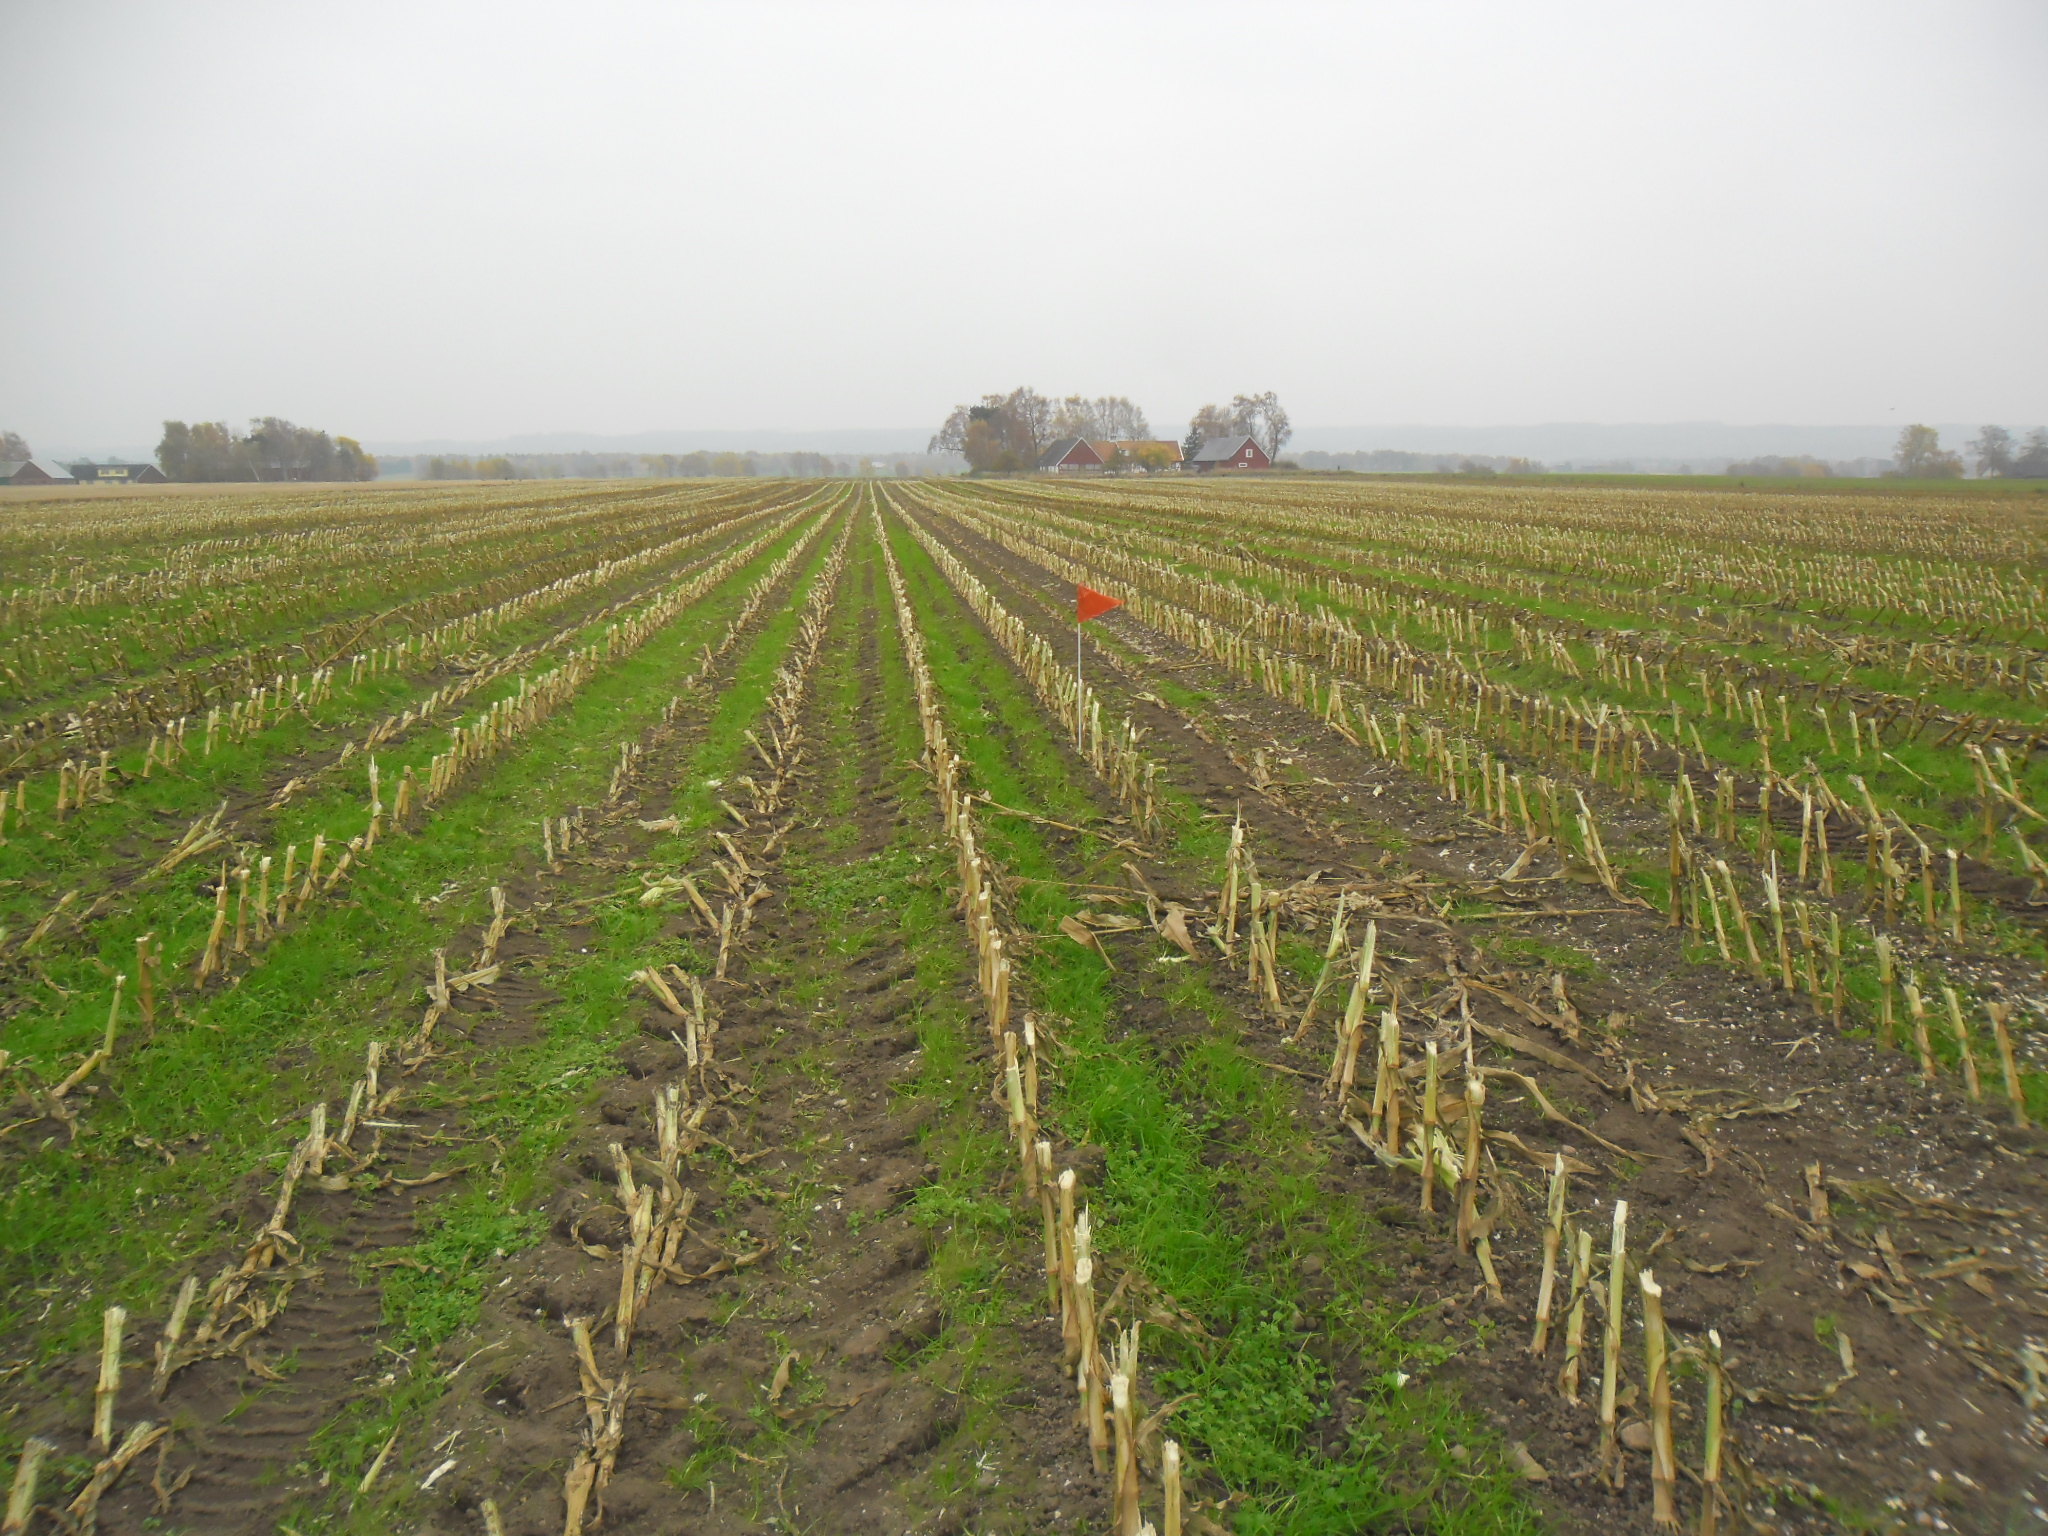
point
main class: Cropland
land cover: Maize
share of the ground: < 10 %
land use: Agriculture (excluding fallow land and kitchen gardens)
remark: Harvested field
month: October
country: SE
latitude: 56.4383
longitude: 13.0949
